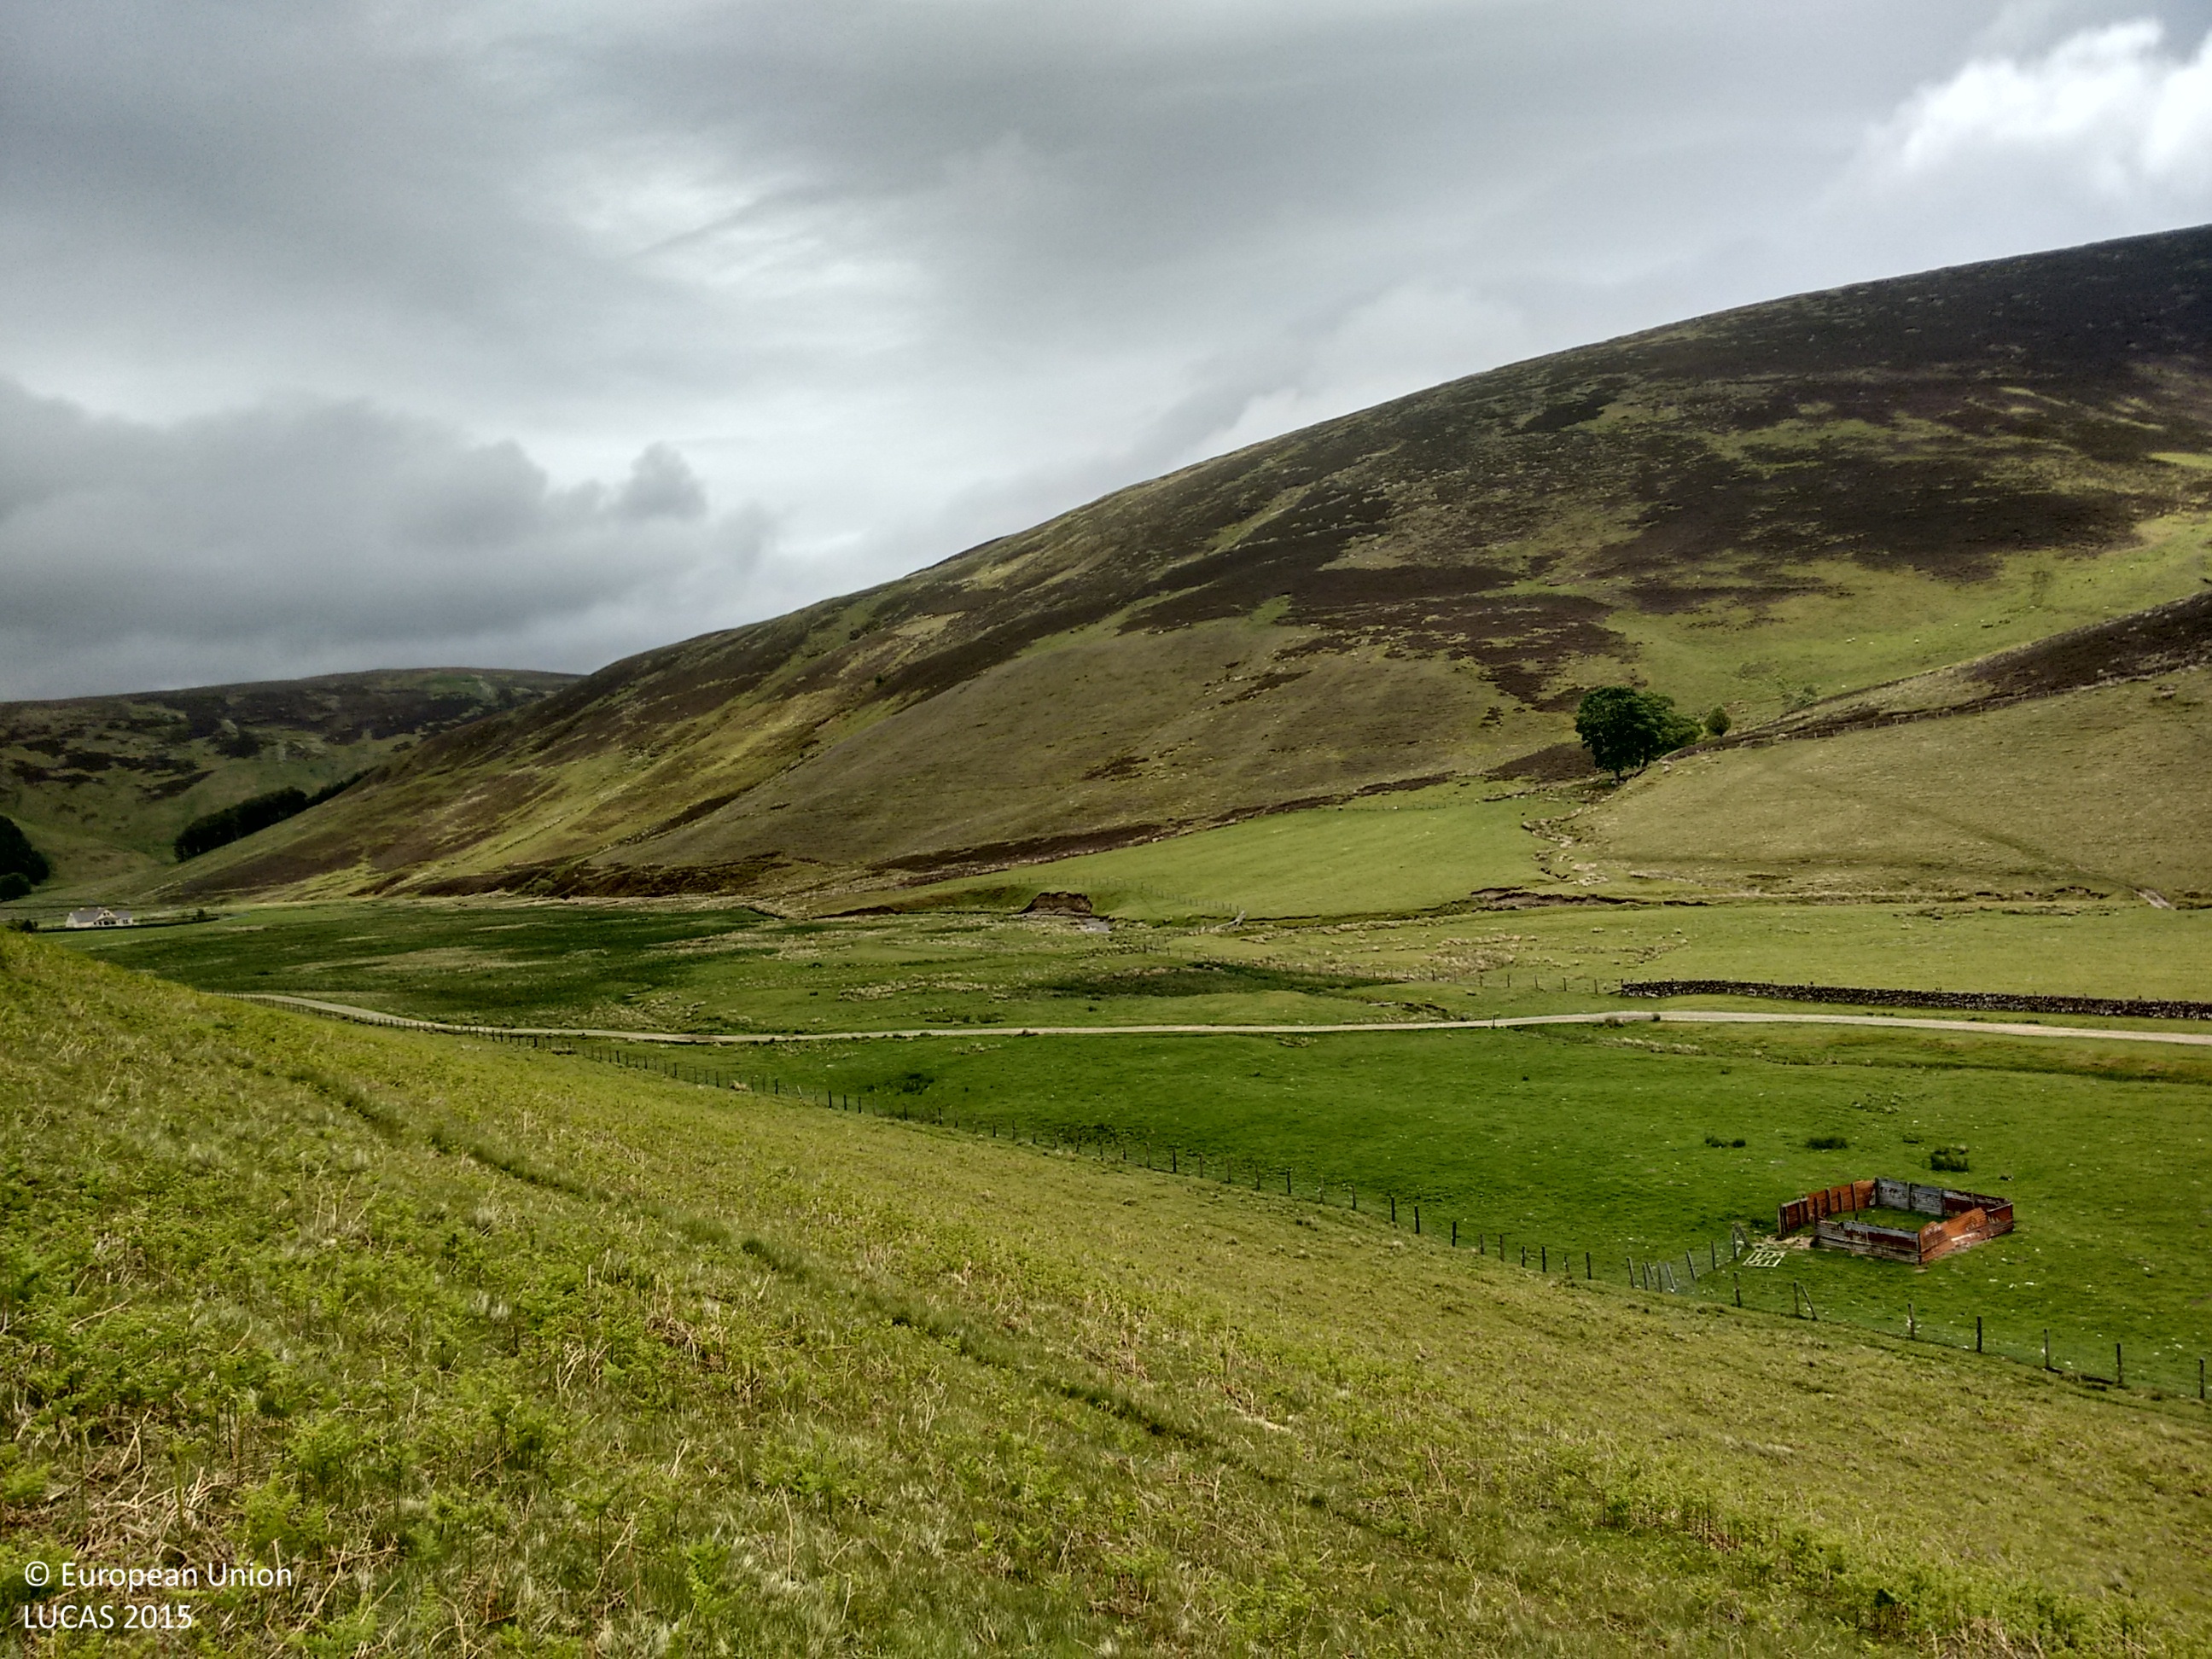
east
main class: Grassland
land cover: Grassland without tree/shrub cover
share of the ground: > 75 %
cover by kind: herbaceous plants 100 %
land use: Agriculture (excluding fallow land and kitchen gardens)
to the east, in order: Grassland without tree/shrub cover; Tracks; Grassland without tree/shrub cover; Rivers and streams; Grassland without tree/shrub cover; Rivers and streams; Dry stone walls; Grassland without tree/shrub cover
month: June
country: GB
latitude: 55.5461
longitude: -3.4709
